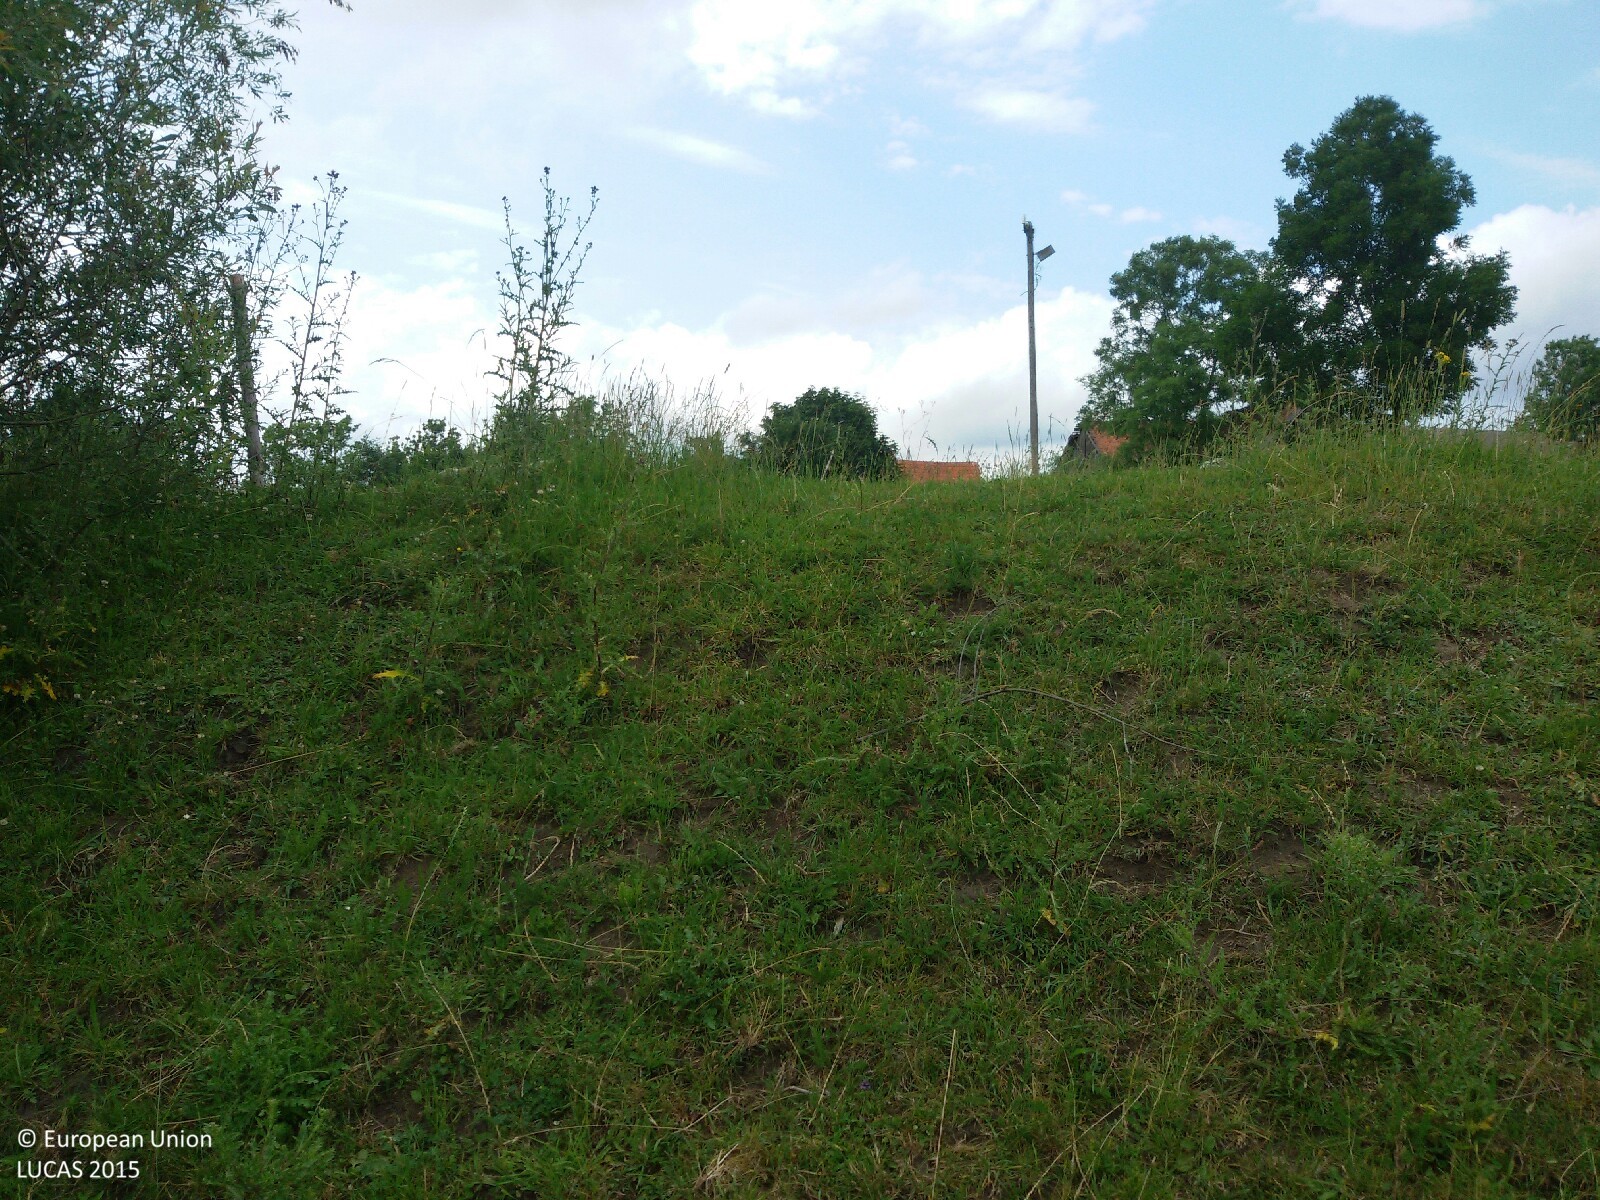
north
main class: Grassland
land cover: Grassland without tree/shrub cover
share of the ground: > 75 %
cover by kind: herbaceous plants 90 %, shrubs 5 %, unconsolidated bare surface 5 %
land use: Agriculture (excluding fallow land and kitchen gardens)
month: July
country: PL
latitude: 54.0863
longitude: 20.2918
